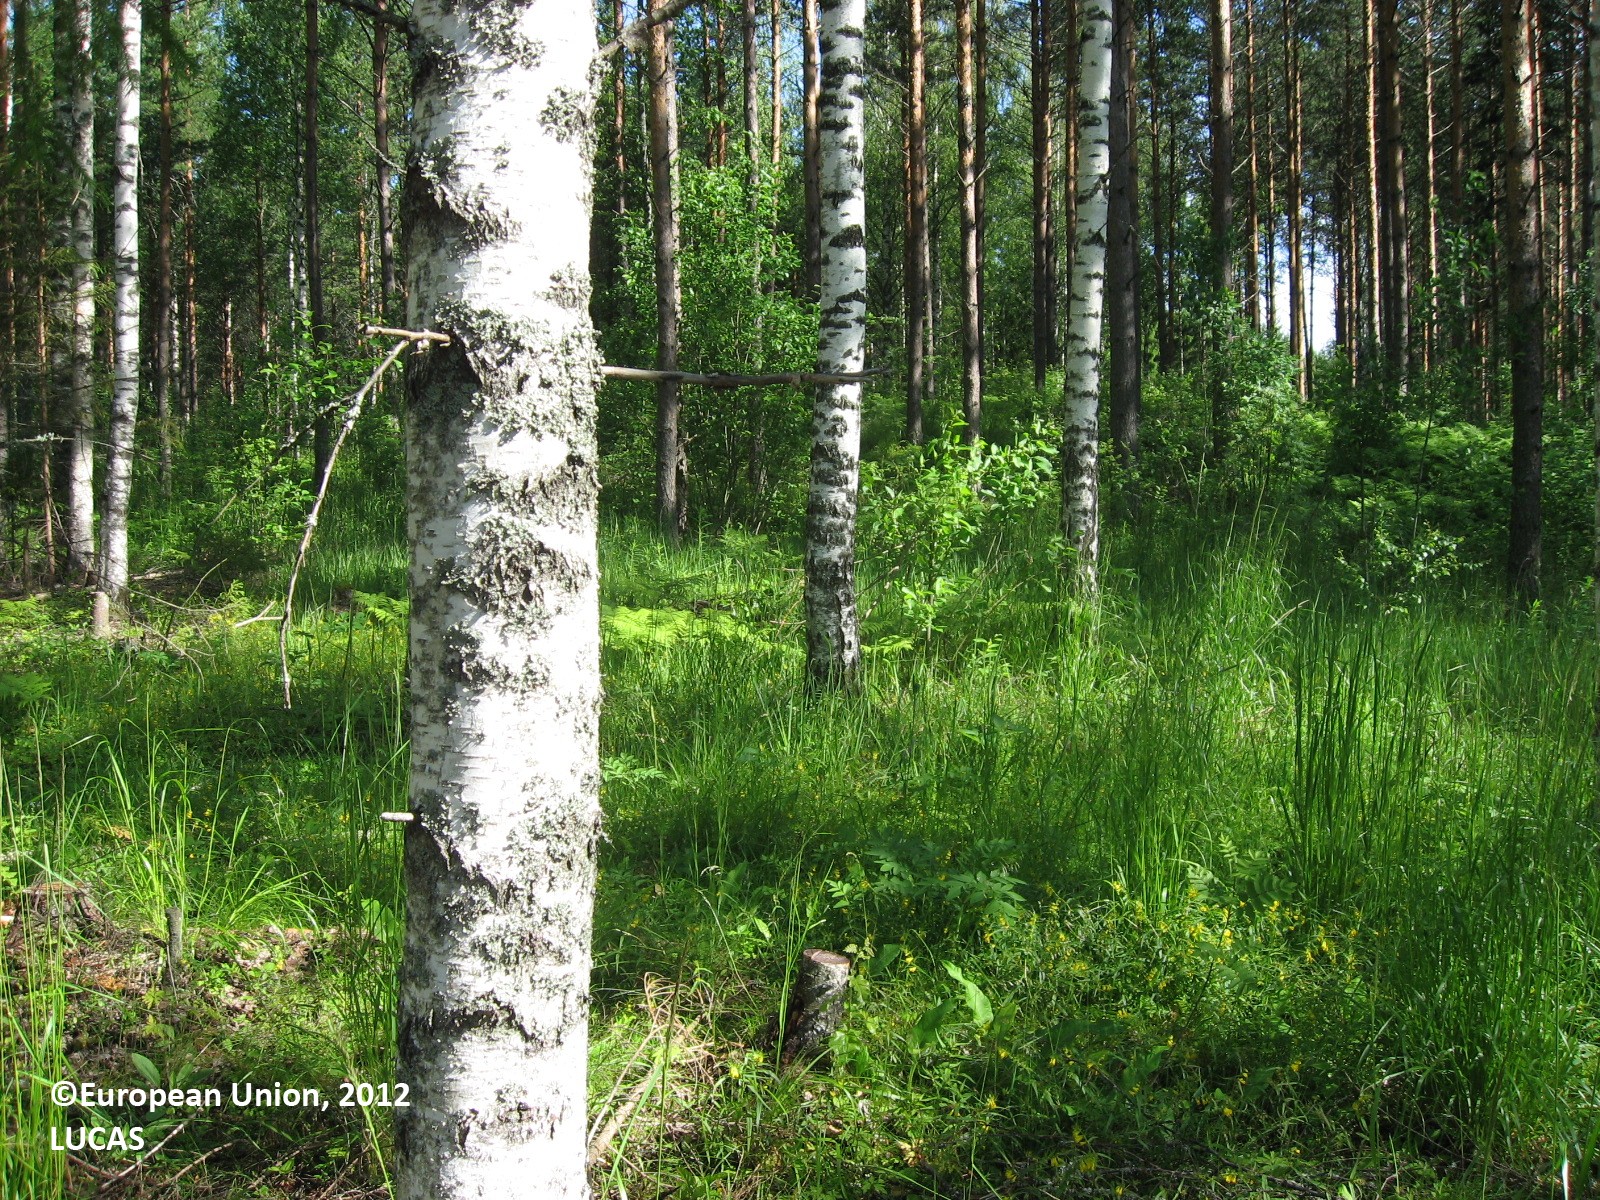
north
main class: Woodland
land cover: Other mixed woodland
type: boreal forest
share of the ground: 25 - 50 %
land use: Forestry
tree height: > 5 m
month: June
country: FI
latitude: 60.6835
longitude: 26.4293
